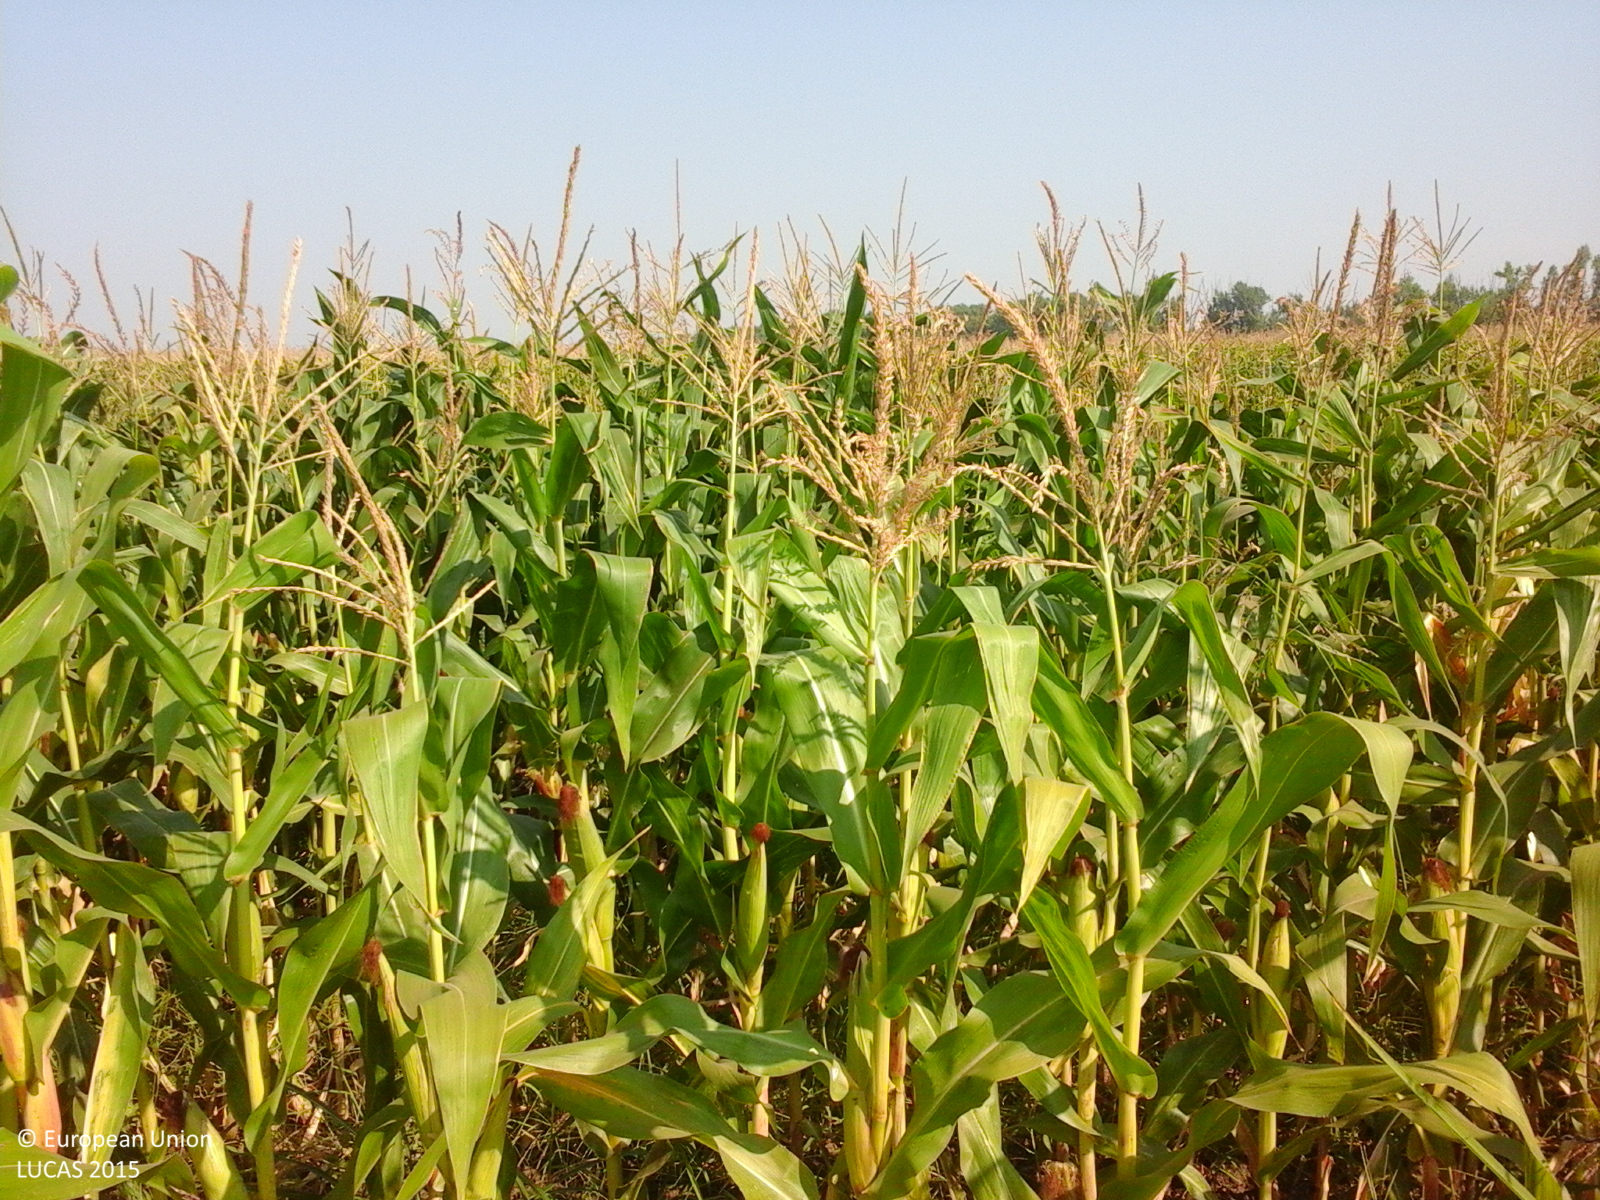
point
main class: Cropland
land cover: Maize
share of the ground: > 75 %
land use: Agriculture (excluding fallow land and kitchen gardens)
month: August
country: RO
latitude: 45.1274
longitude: 27.4260
